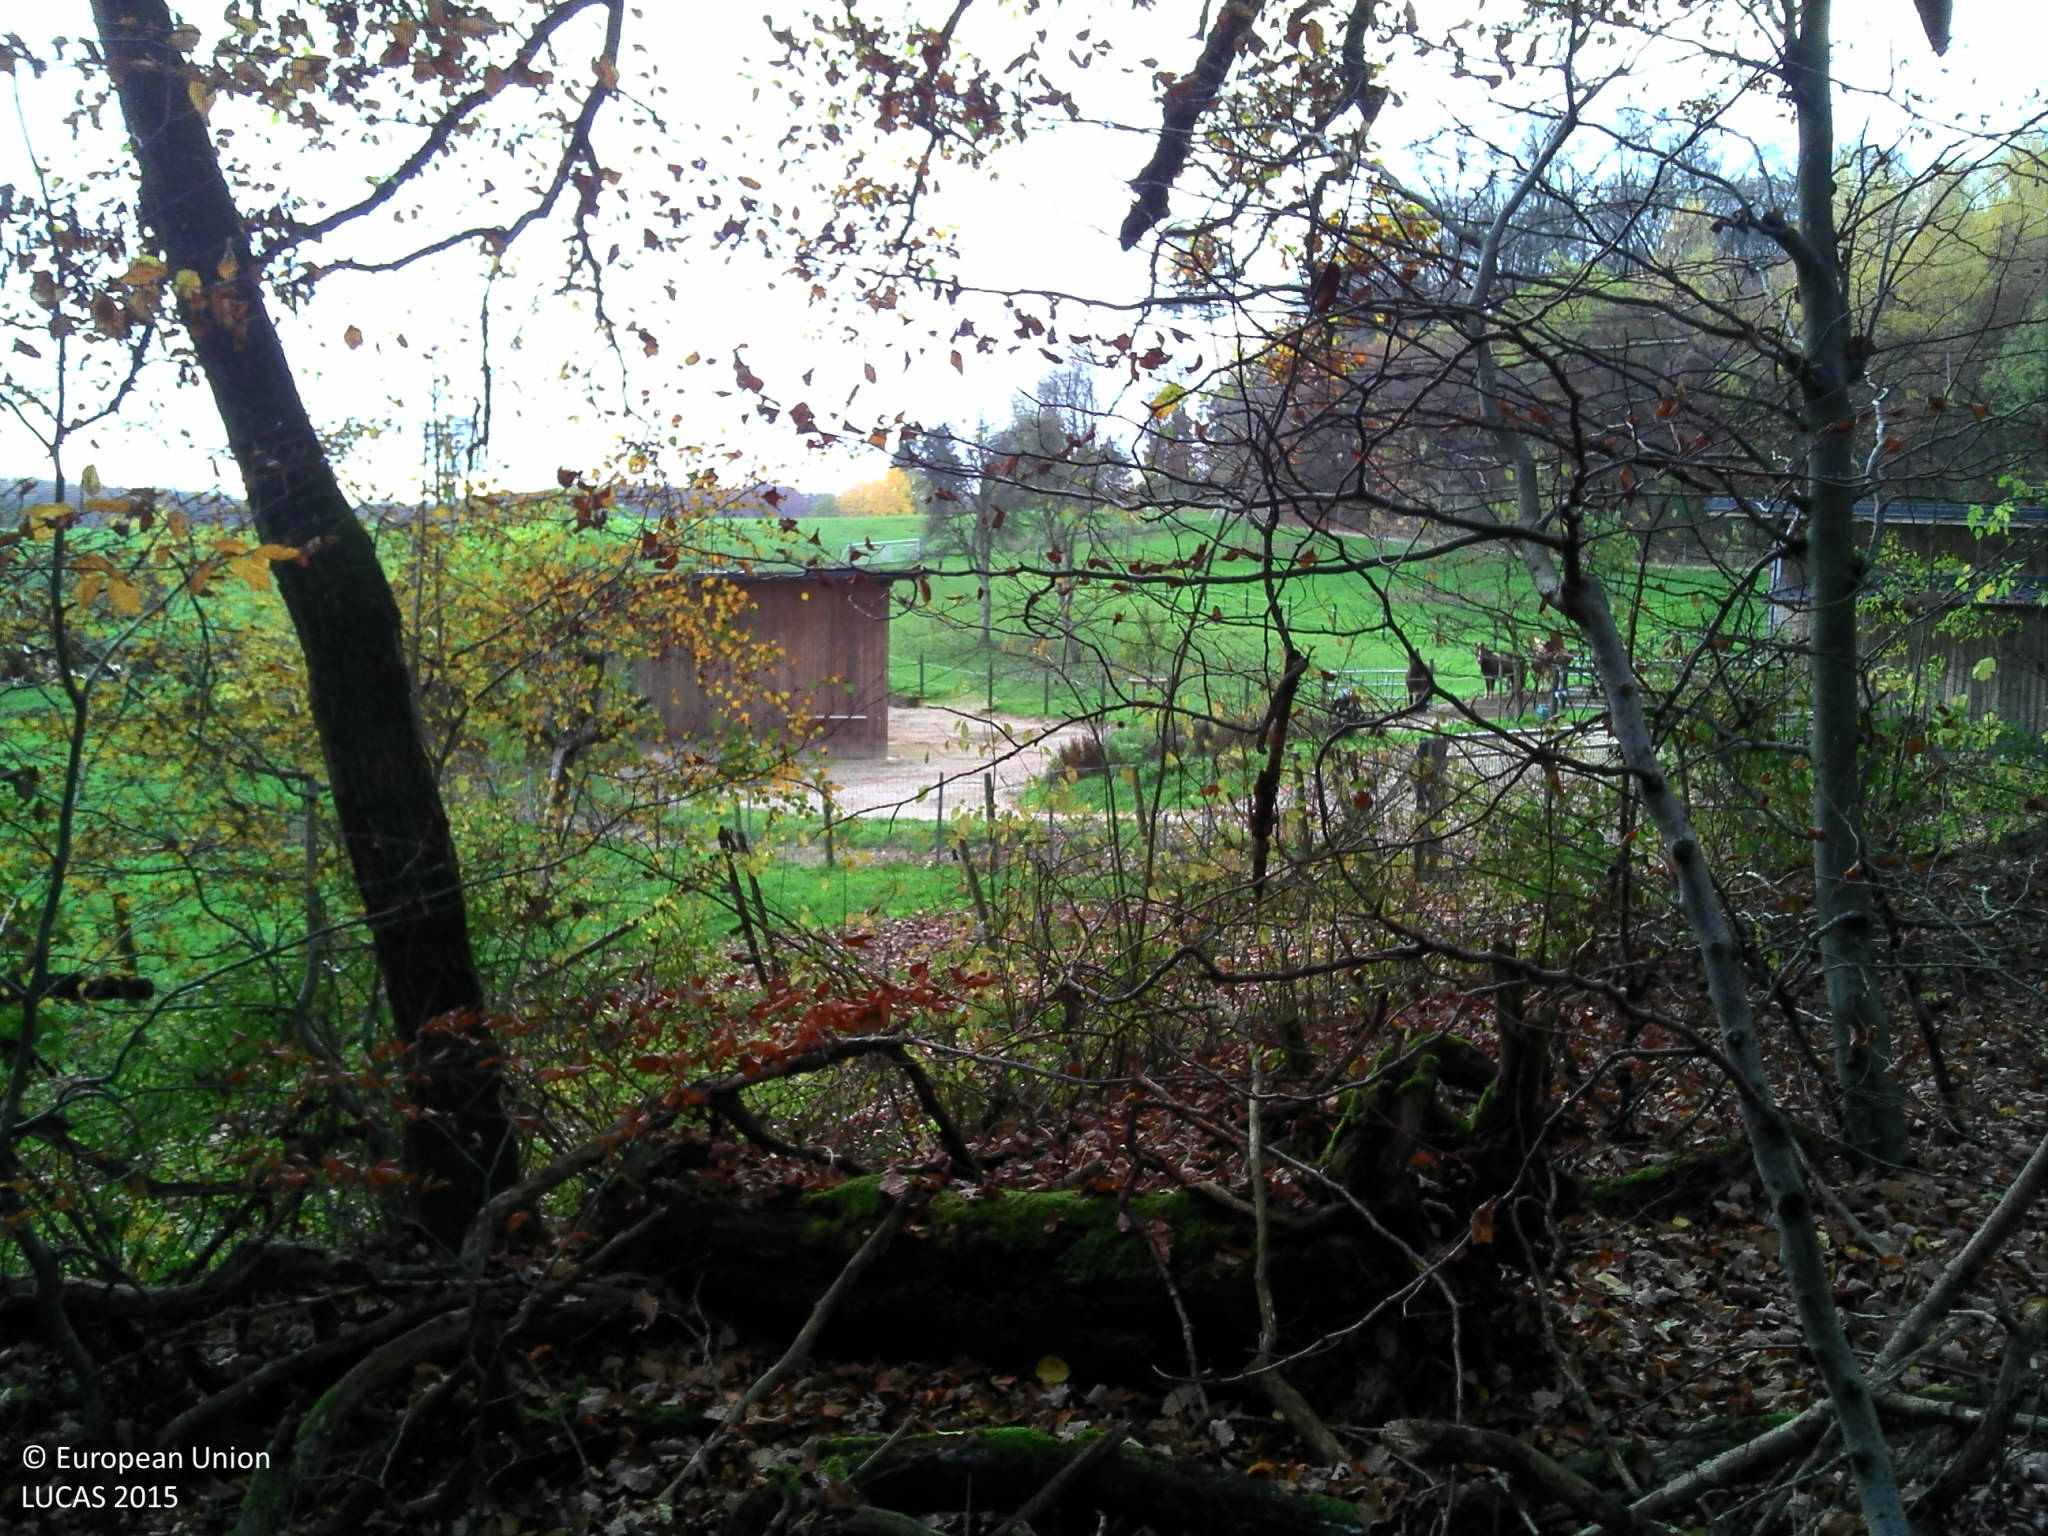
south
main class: Woodland
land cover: Broadleaved woodland
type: beech forest
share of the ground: > 75 %
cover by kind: broadleaved forest trees 100 %
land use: Forestry
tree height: > 5 m
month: November
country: LU
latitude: 49.6032
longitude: 6.3328
